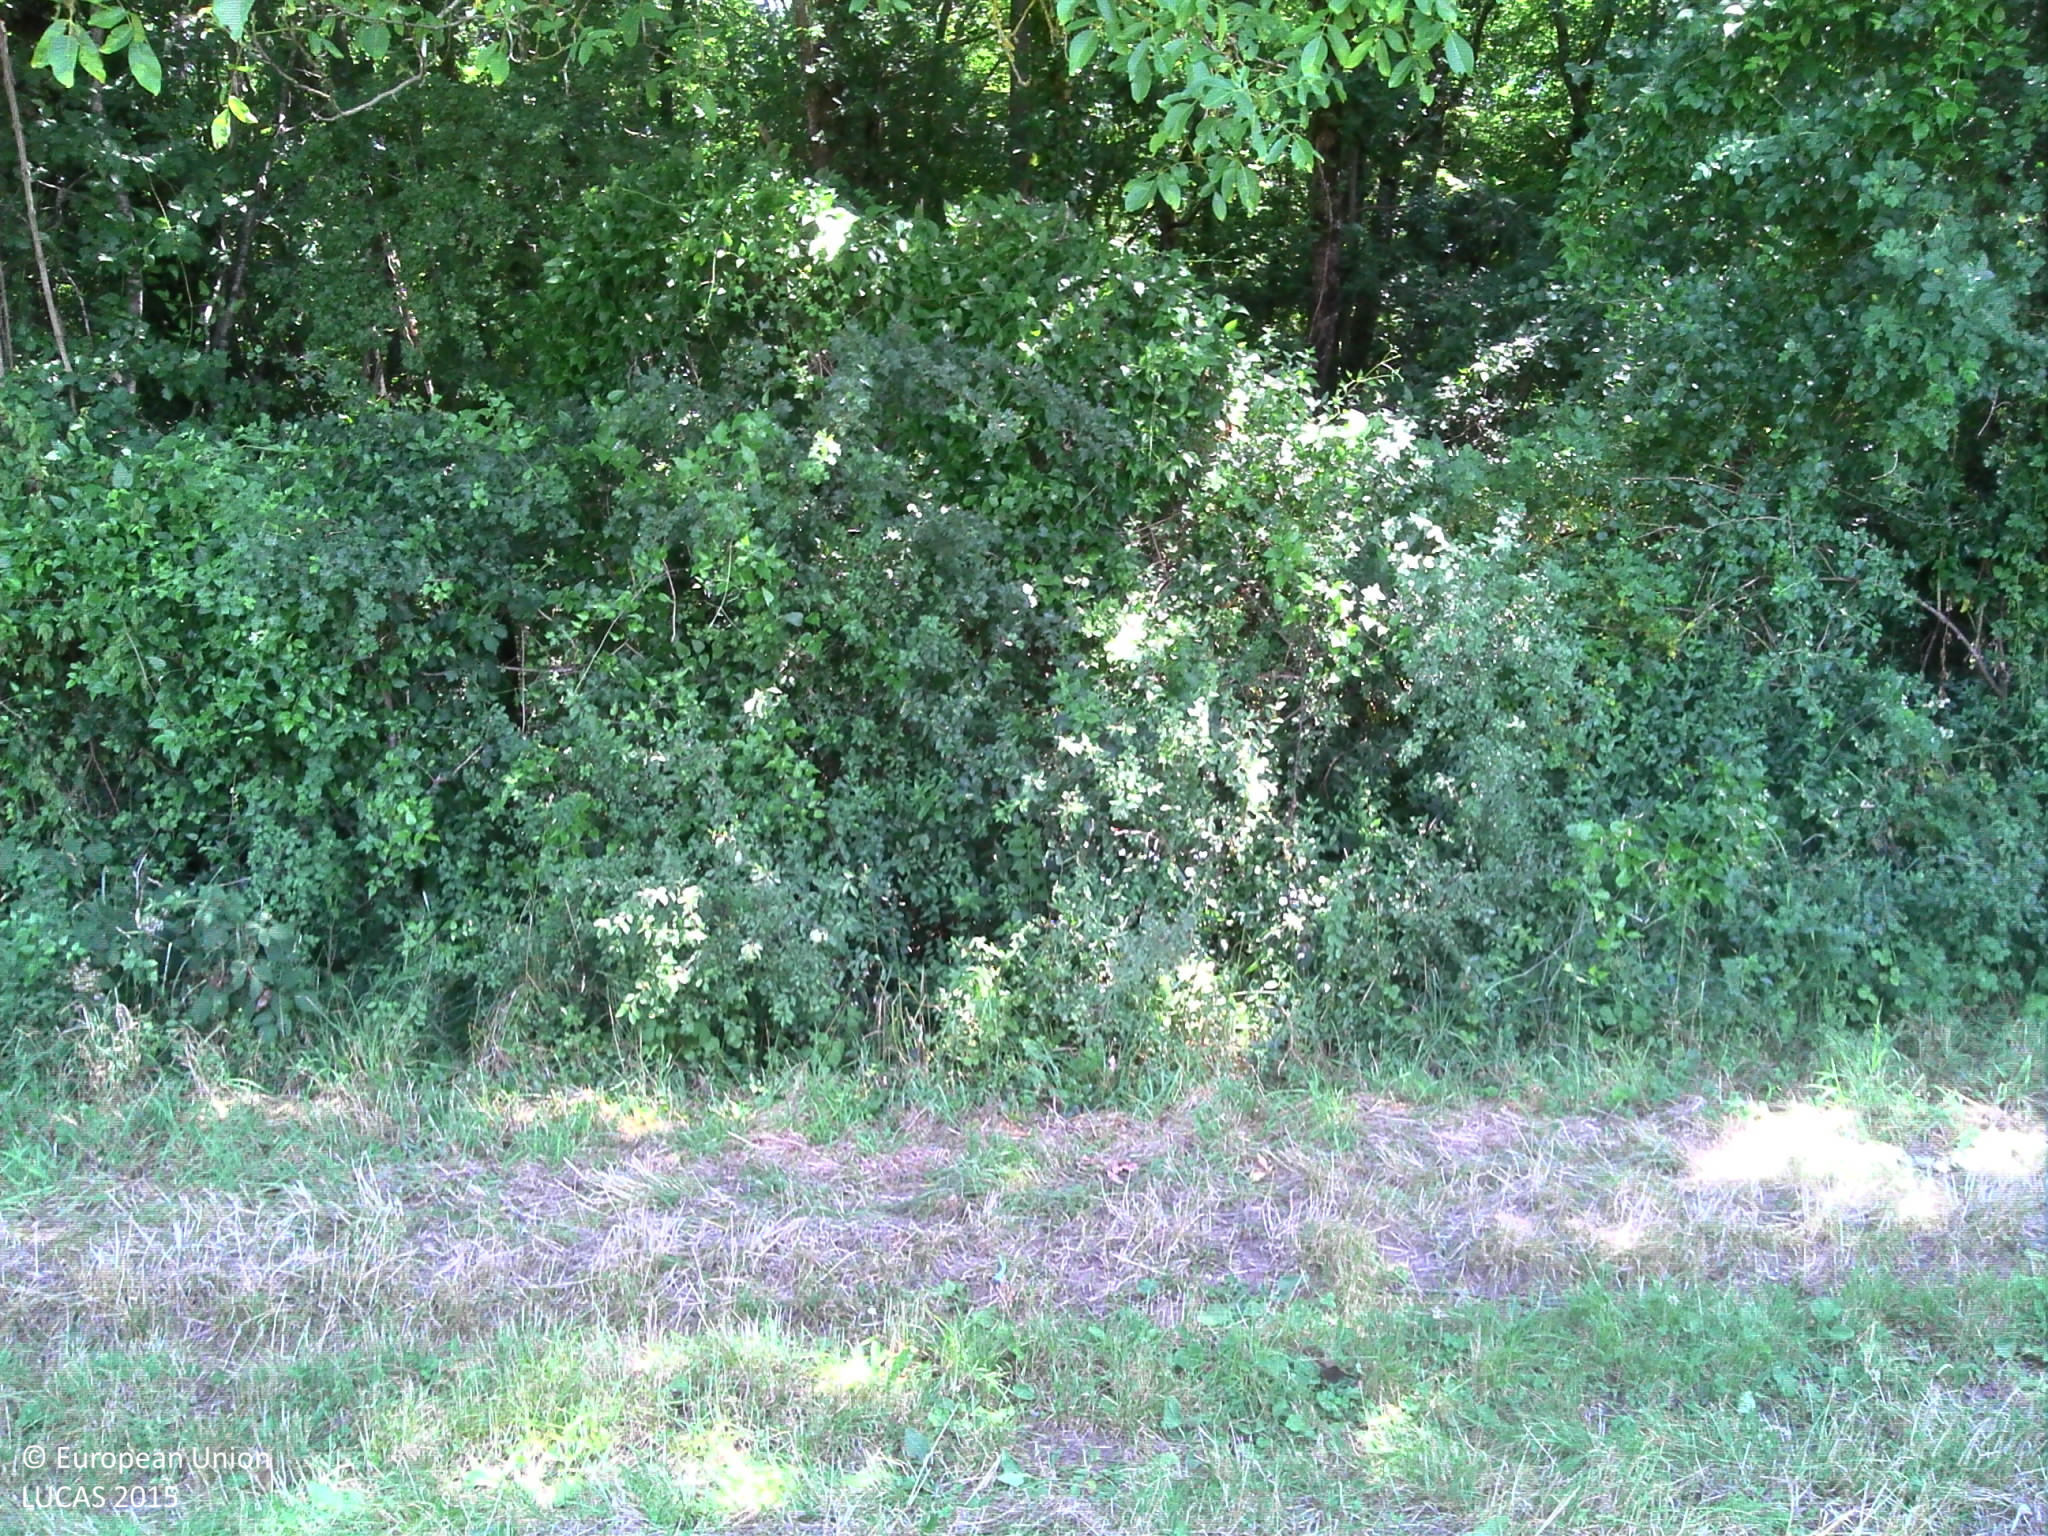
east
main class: Cropland
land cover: Rape and turnip rape
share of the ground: > 75 %
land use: Agriculture (excluding fallow land and kitchen gardens)
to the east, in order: Rape and turnip rape; Grassland without tree/shrub cover; Broadleaved woodland; Shrubland without tree cover; Spruce dominated coniferous woodland; Shrubland without tree cover; Broadleaved woodland
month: July
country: FR
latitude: 47.5130
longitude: 3.5829
